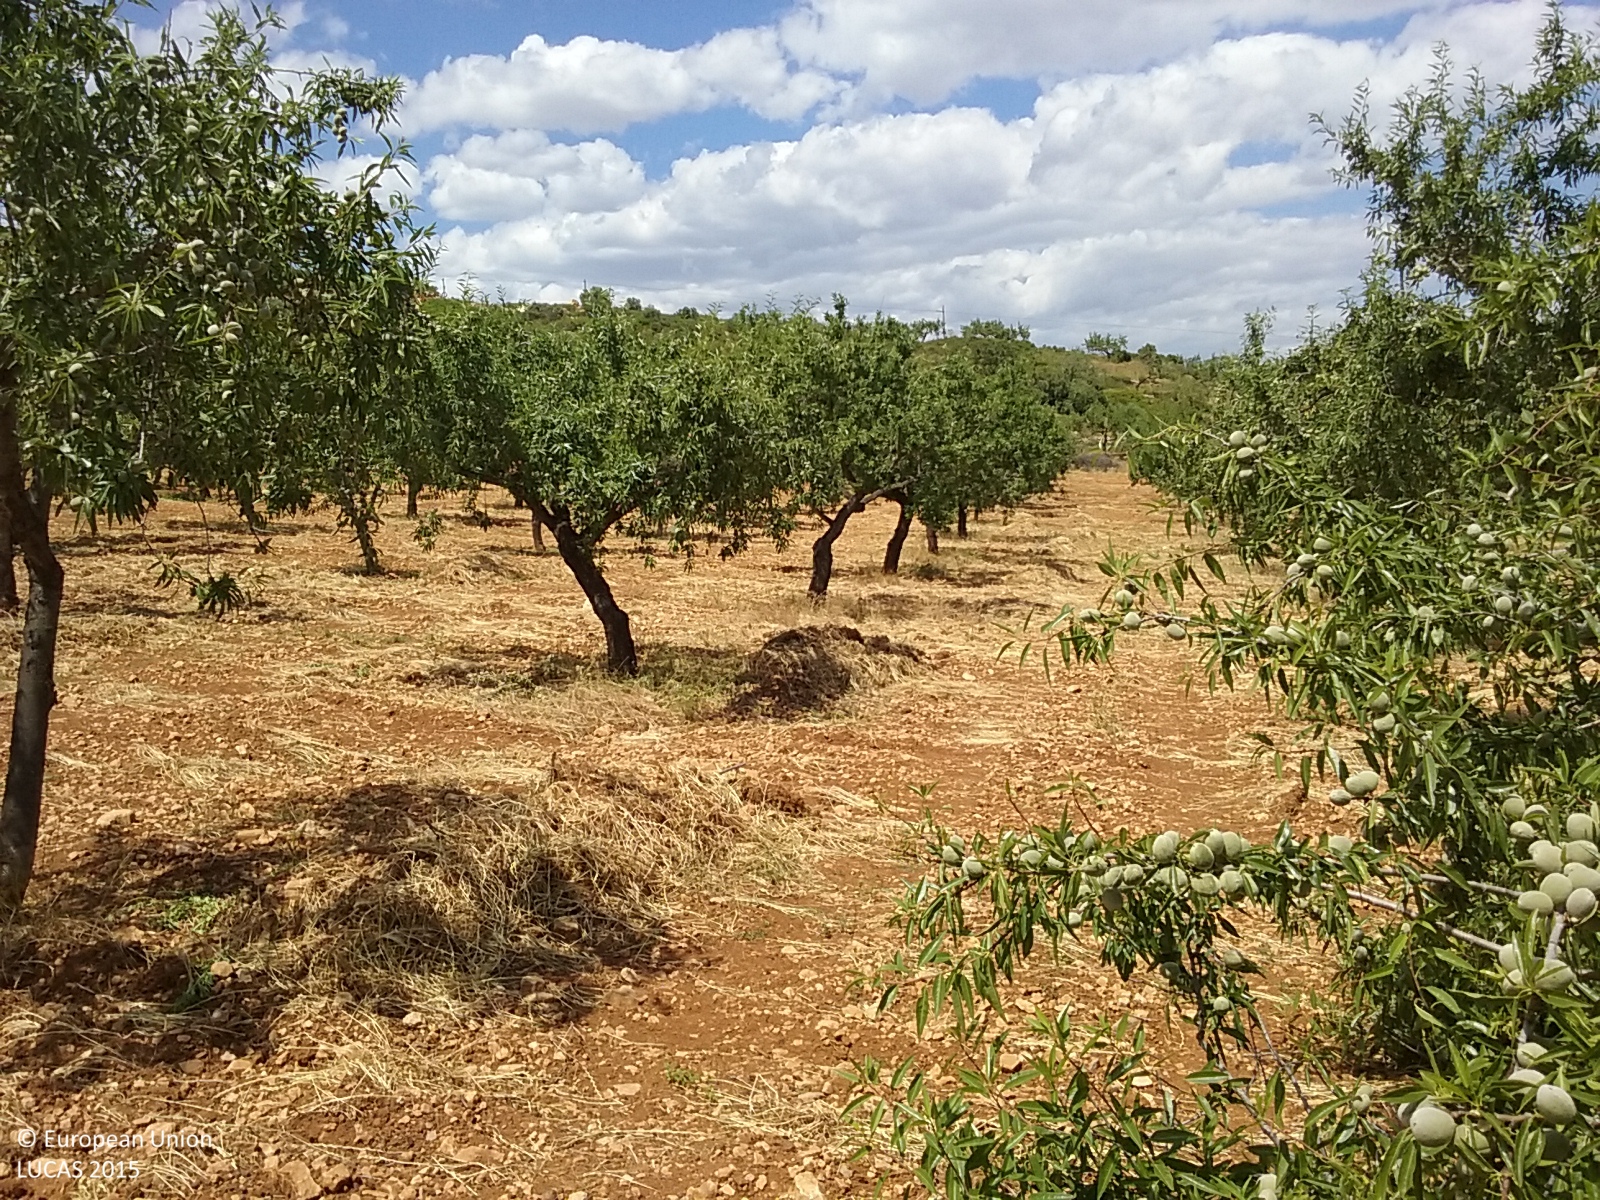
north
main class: Cropland
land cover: Nuts trees
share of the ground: 25 - 50 %
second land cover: Other bare soil
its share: > 75 %
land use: Agriculture (excluding fallow land and kitchen gardens)
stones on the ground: 10 - 25 %
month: May
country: ES
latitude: 40.3477
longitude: 0.0949
